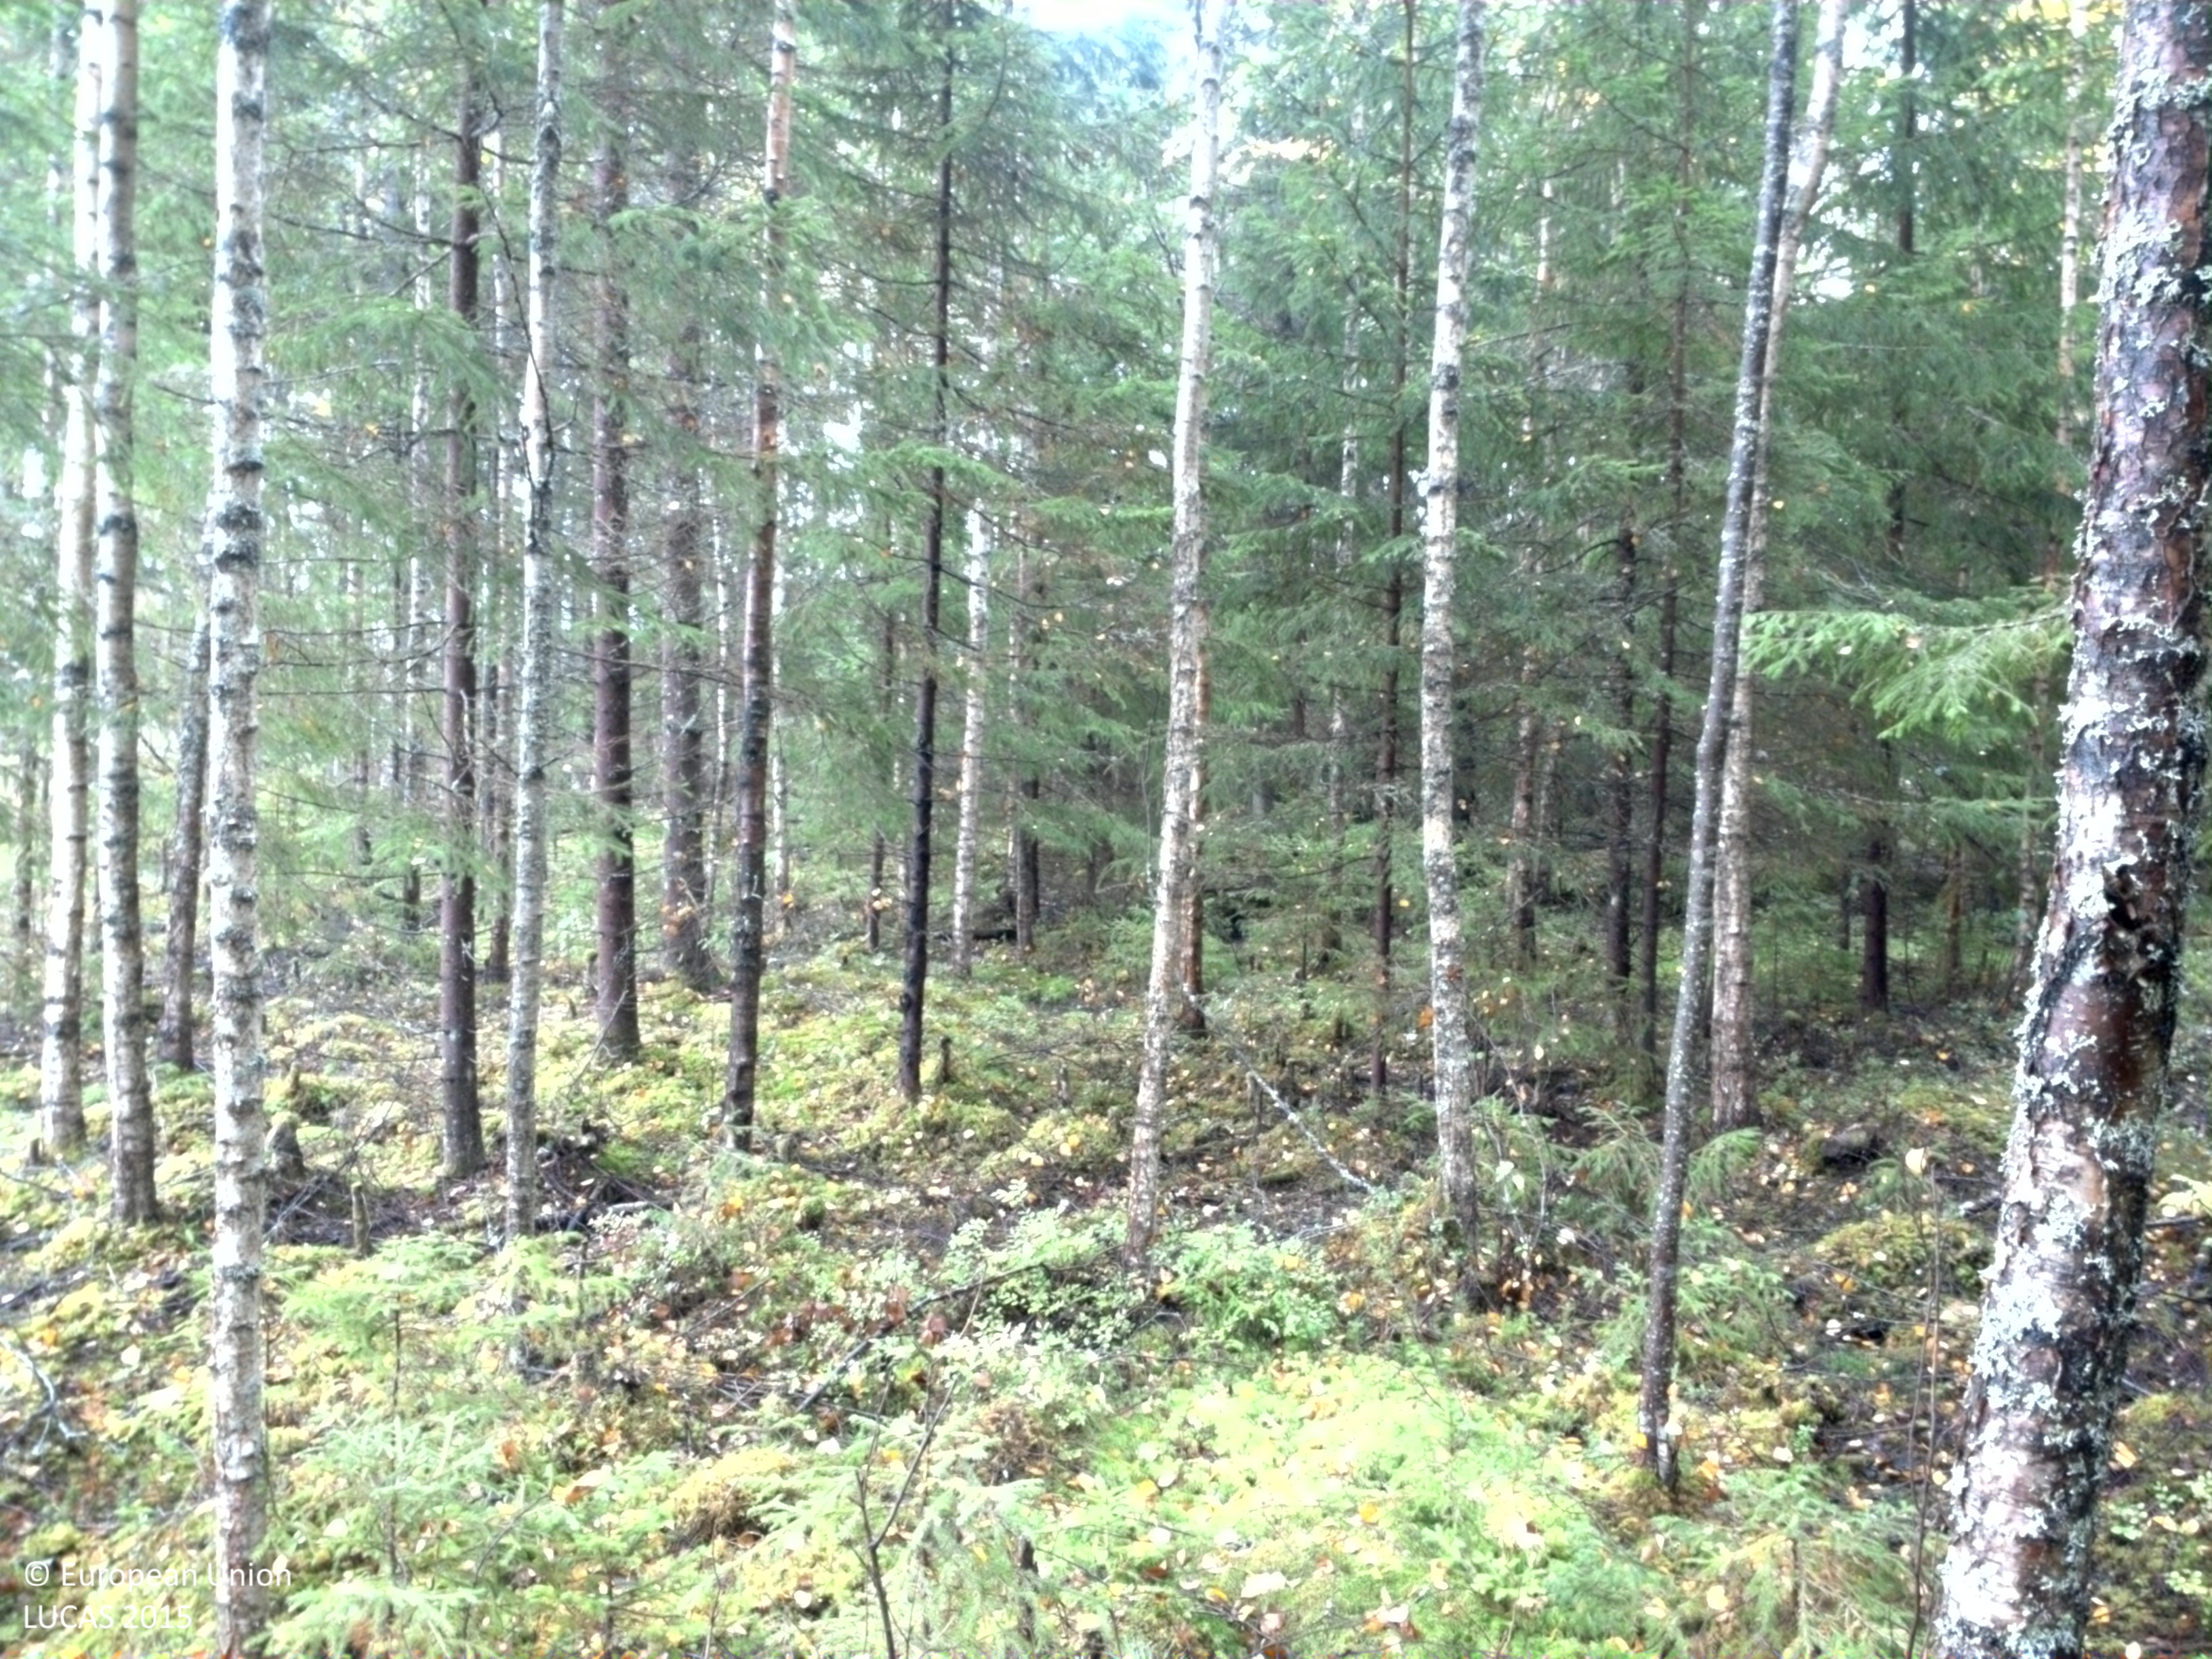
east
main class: Woodland
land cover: Spruce dominated mixed woodland
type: boreal forest
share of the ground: 50 - 75 %
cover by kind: coniferous forest trees 30 %, broadleaved forest trees 20 %, shrubs 20 %, lichens and mosses 20 %, herbaceous plants 10 %
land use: Forestry
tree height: > 5 m
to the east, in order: Spruce dominated mixed woodland; Spontaneously vegetated surfaces; Spruce dominated coniferous woodland
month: September
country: SE
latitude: 58.9693
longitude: 14.0448
